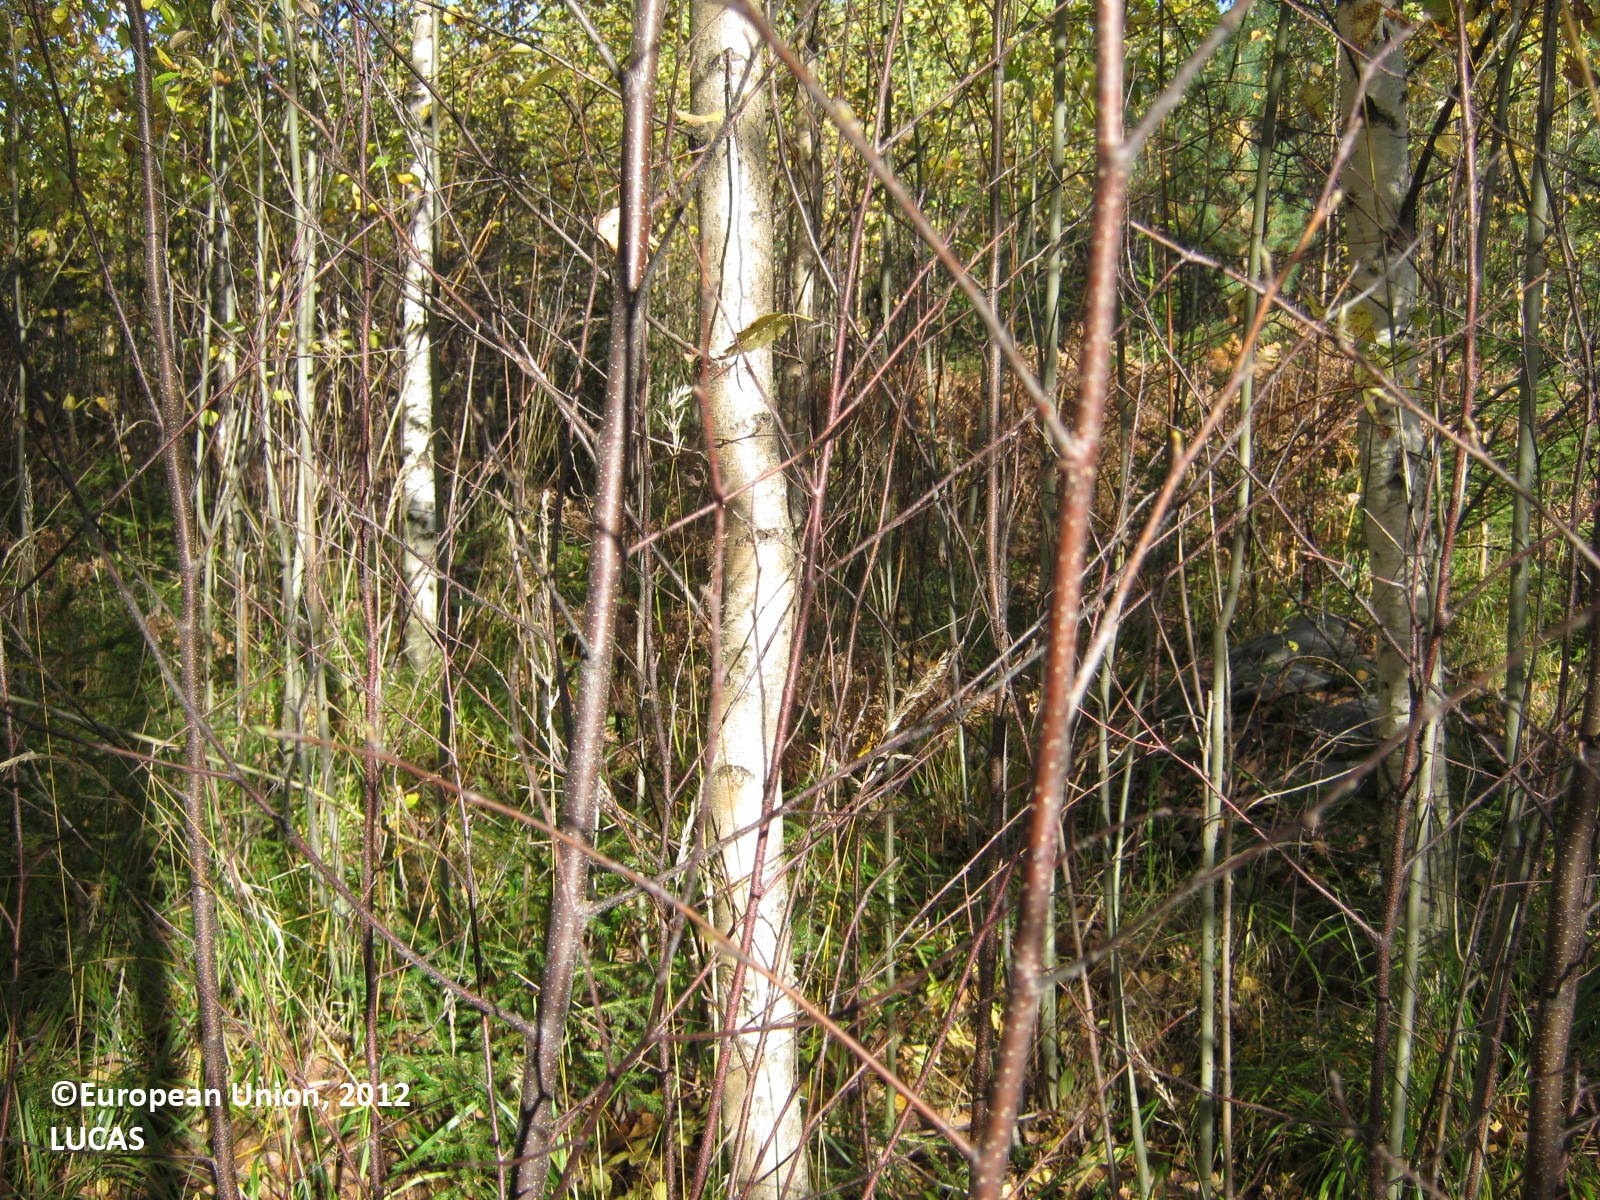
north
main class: Woodland
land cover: Broadleaved woodland
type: boreal forest
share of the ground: > 75 %
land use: Forestry
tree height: > 5 m
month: September
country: FI
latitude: 62.3973
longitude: 28.8052
